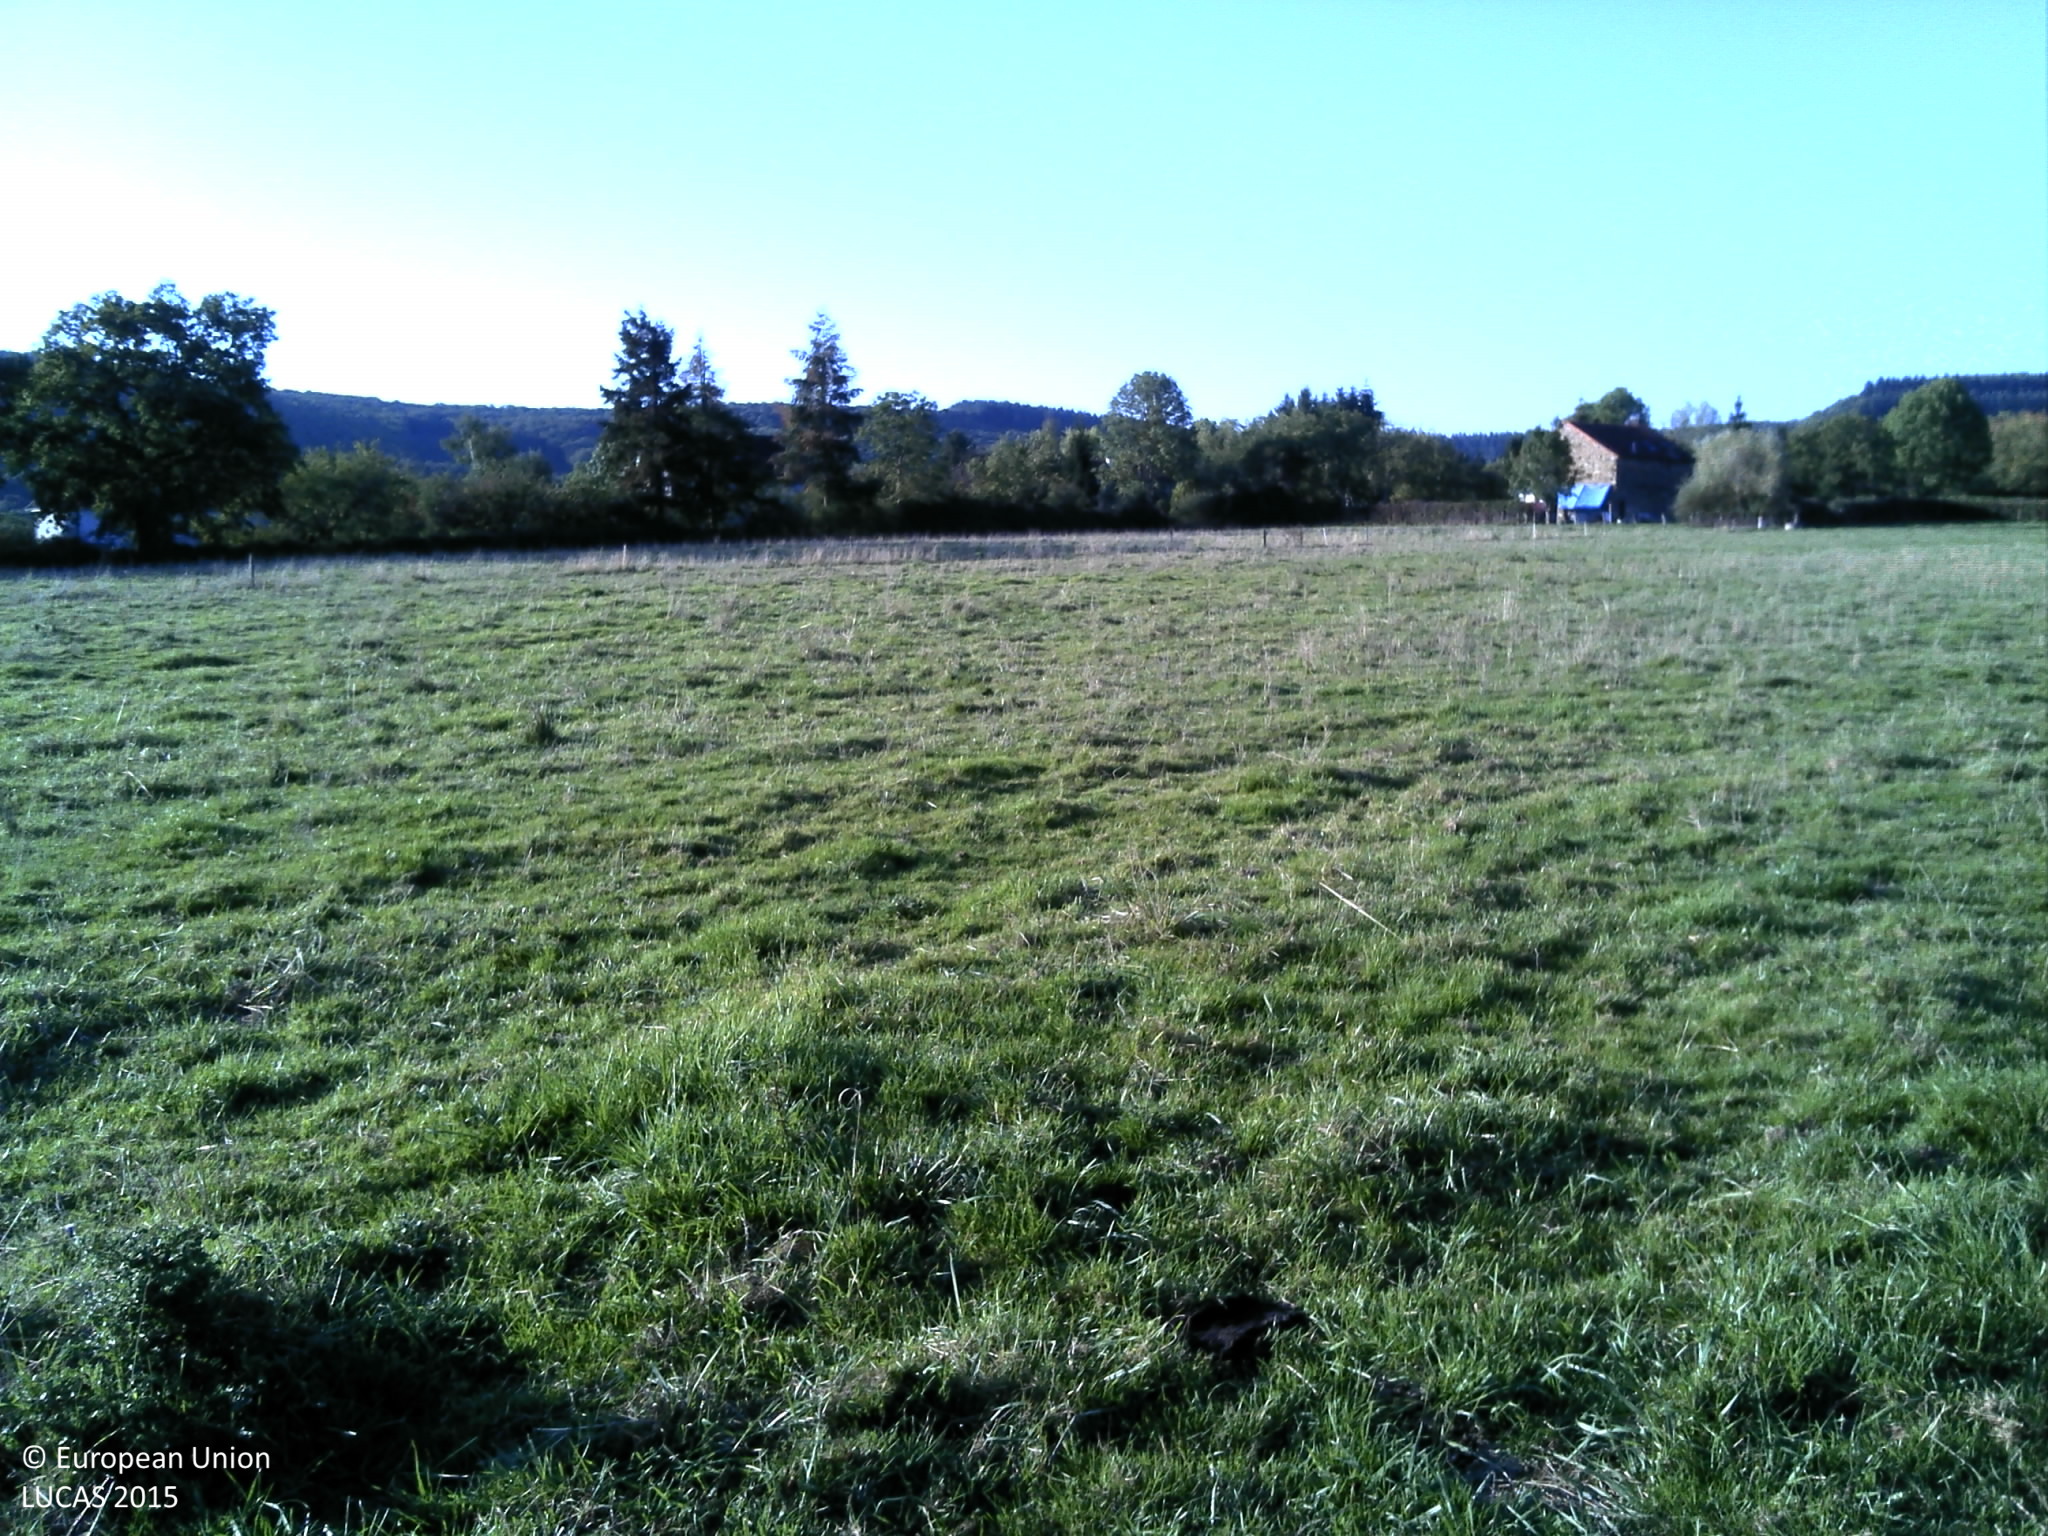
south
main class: Grassland
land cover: Grassland with sparse tree/shrub cover
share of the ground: > 75 %
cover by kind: herbaceous plants 95 %, broadleaved forest trees 5 %
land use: Agriculture (excluding fallow land and kitchen gardens)
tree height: > 5 m
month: September
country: FR
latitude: 46.9813
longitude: 4.4127
